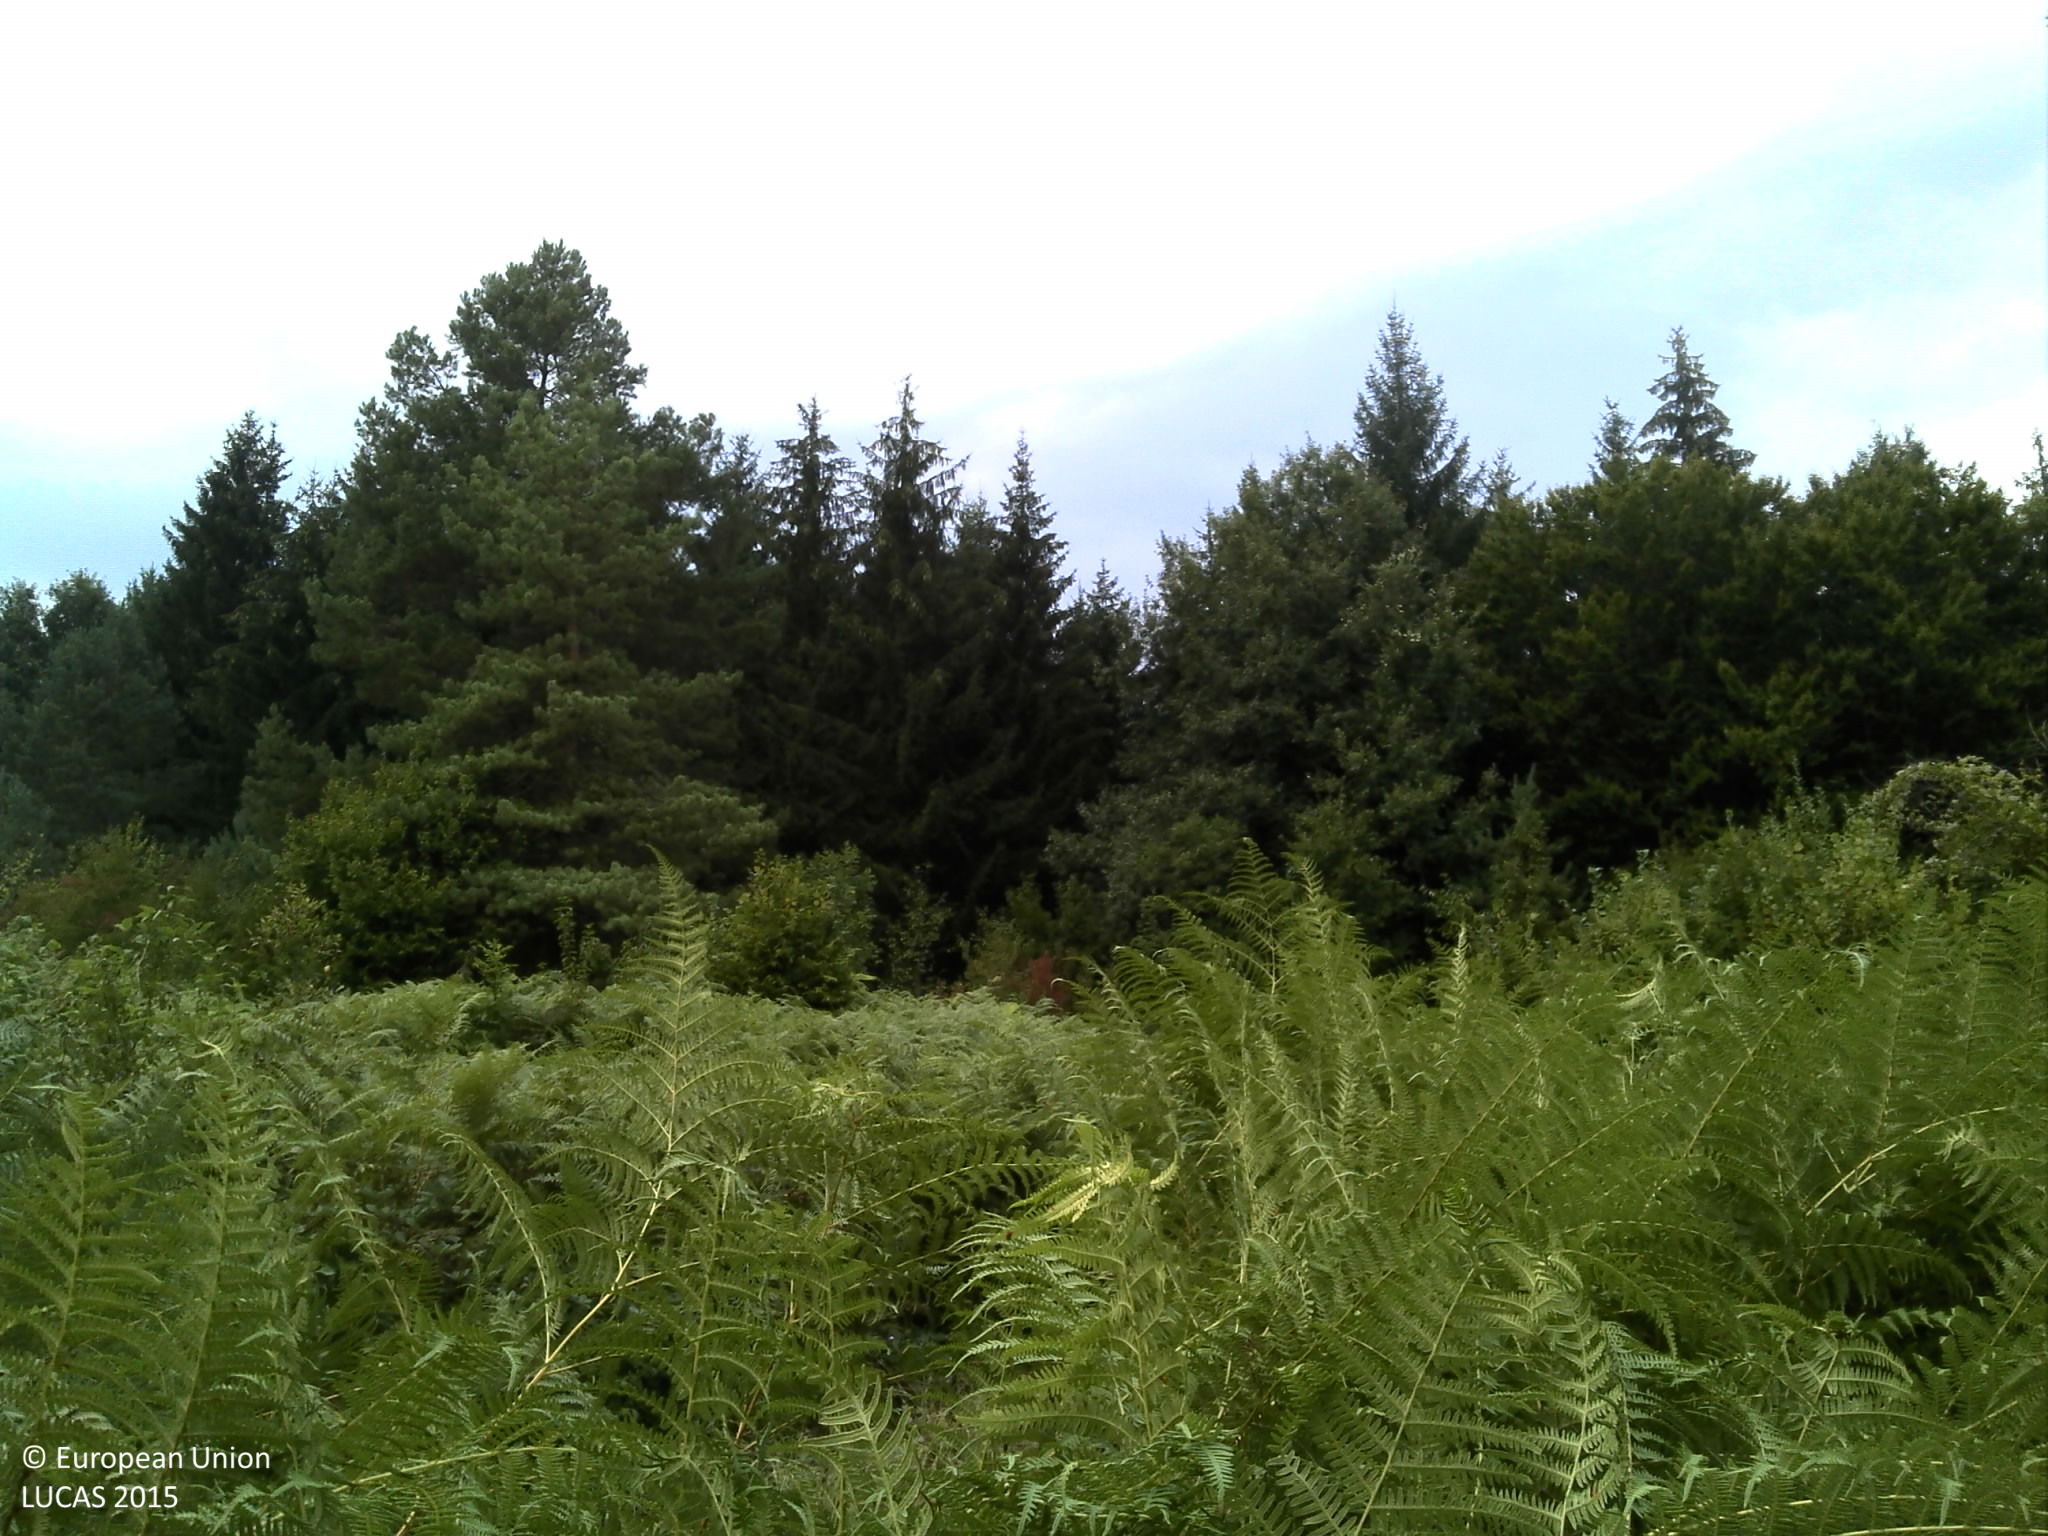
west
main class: Shrubland
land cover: Shrubland with sparse tree cover
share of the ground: > 75 %
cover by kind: shrubs 85 %, herbaceous plants 10 %, broadleaved forest trees 5 %
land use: Semi-natural and natural areas not in use
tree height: < 5 m
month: September
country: HR
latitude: 45.1568
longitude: 15.6052
